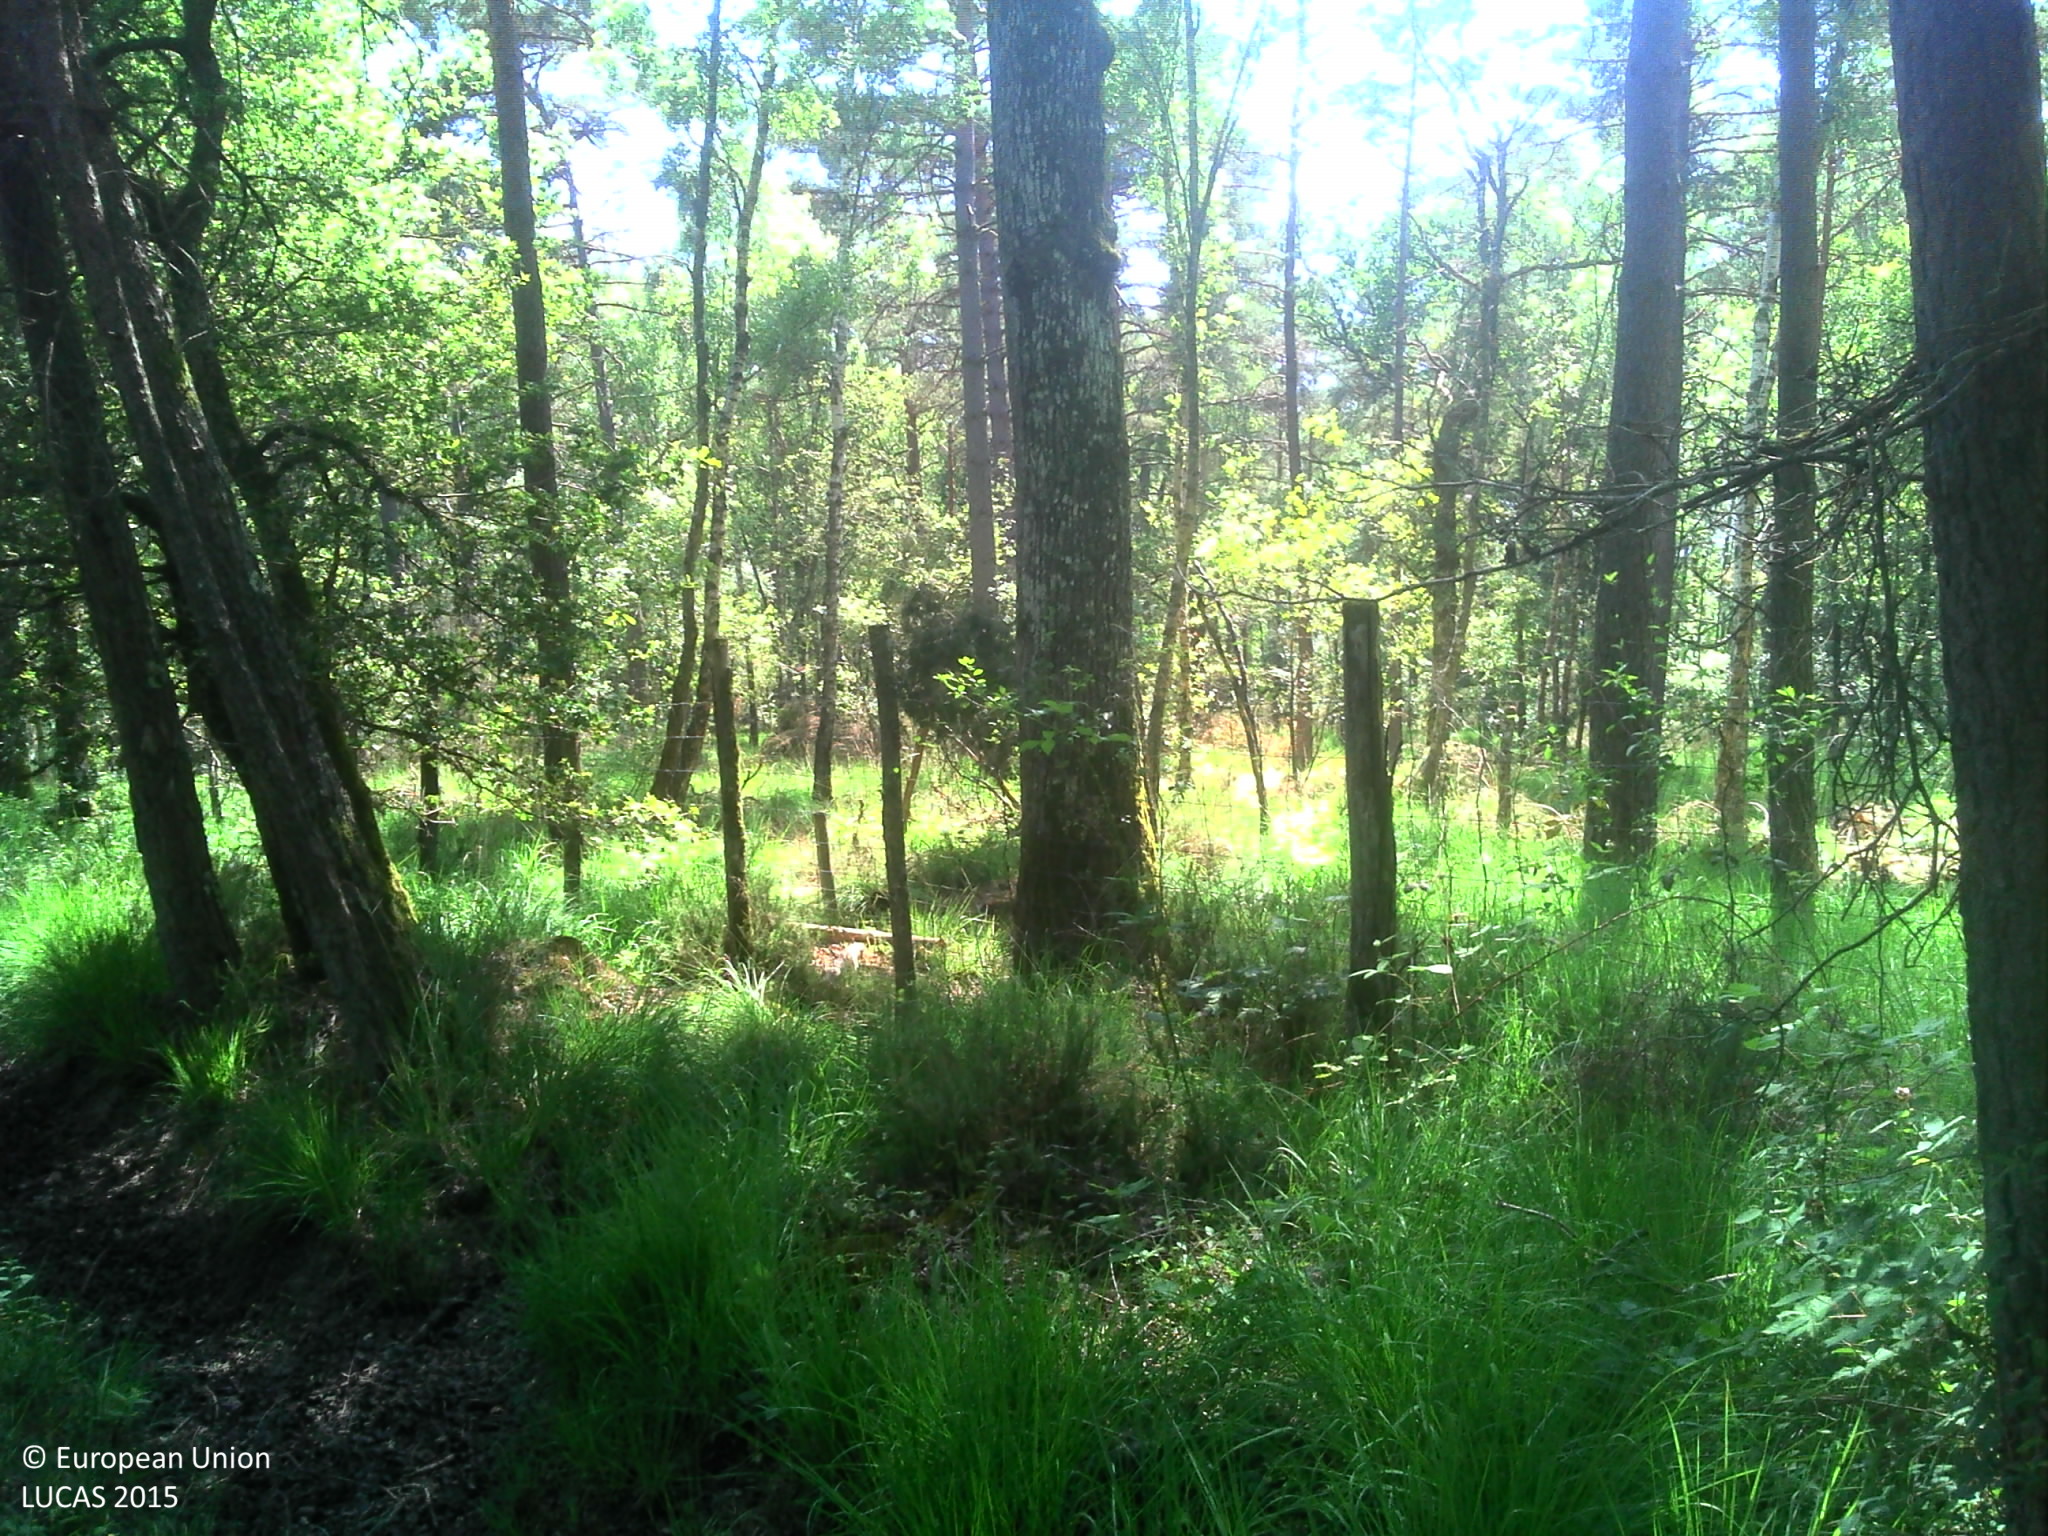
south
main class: Woodland
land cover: Pine dominated mixed woodland
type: thermophilous deciduous forest
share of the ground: > 75 %
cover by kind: herbaceous plants 50 %, unconsolidated bare surface 30 %, coniferous forest trees 10 %, broadleaved forest trees 10 %
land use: Forestry
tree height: > 5 m
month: June
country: FR
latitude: 47.4414
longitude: 1.4863
